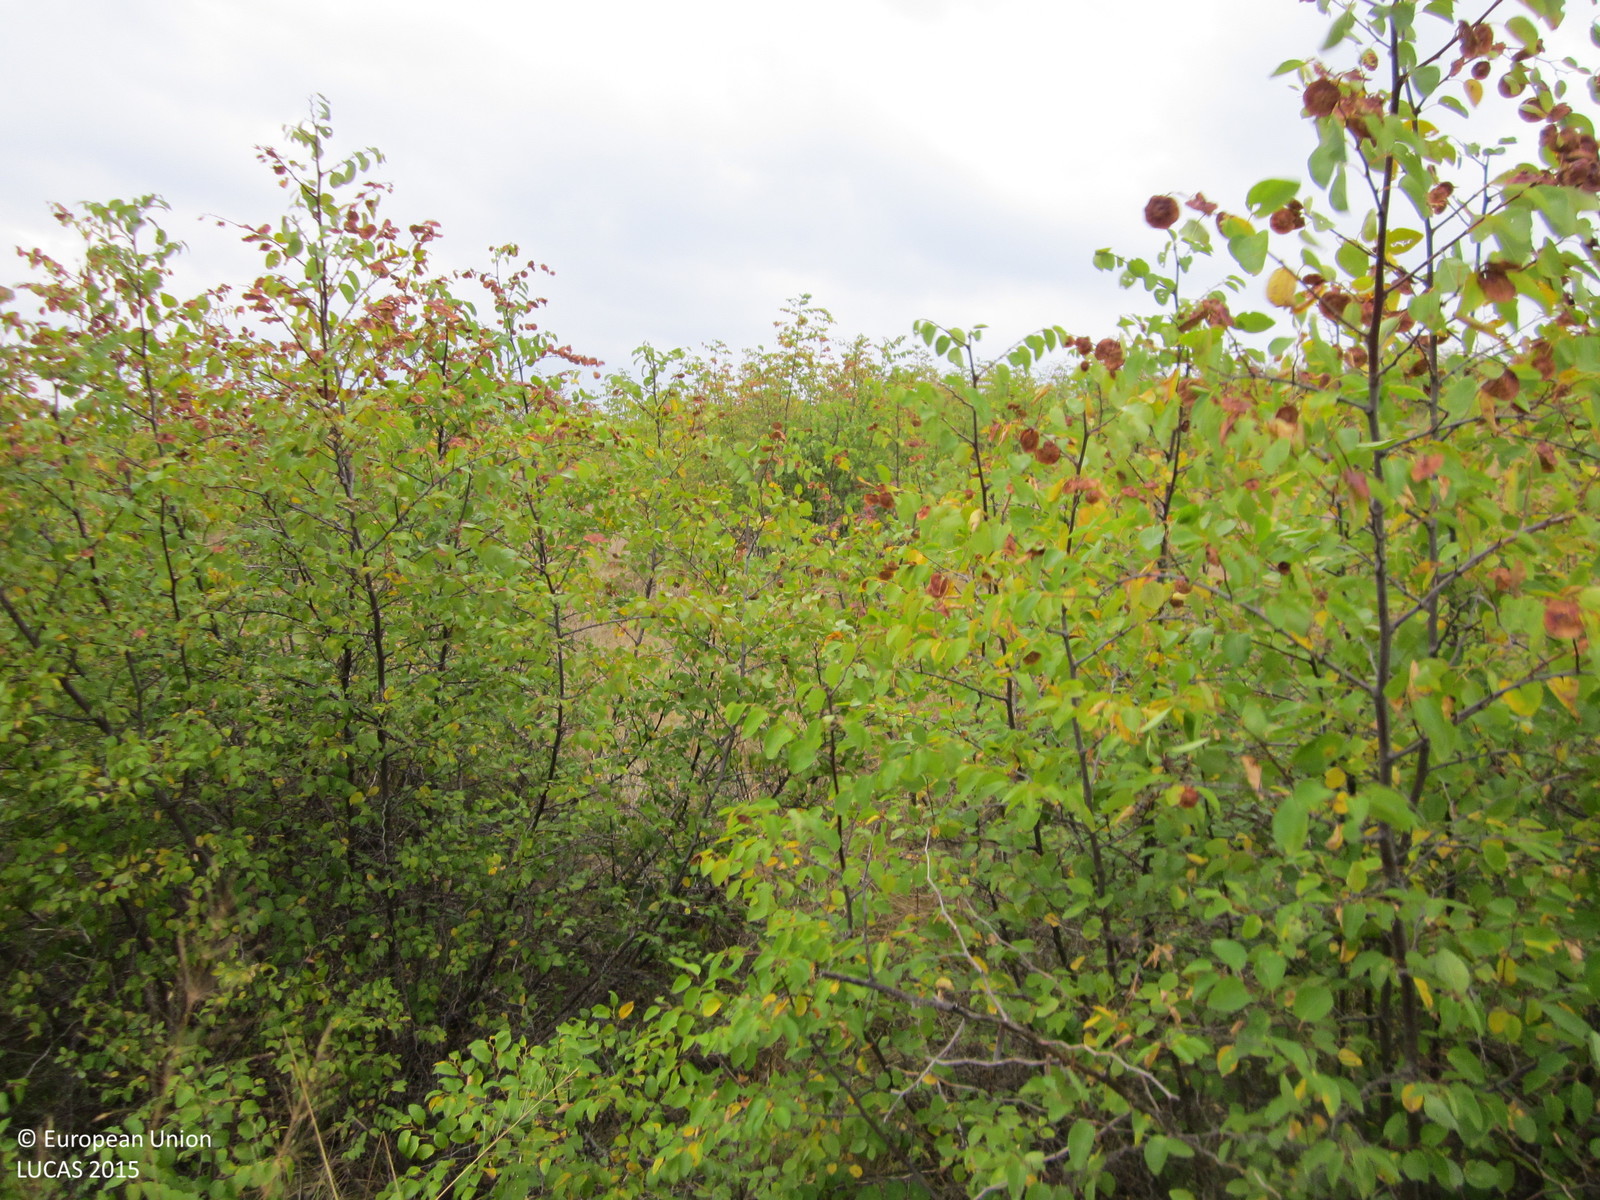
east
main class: Shrubland
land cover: Shrubland without tree cover
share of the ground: 50 - 75 %
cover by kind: shrubs 60 %, herbaceous plants 40 %
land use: Semi-natural and natural areas not in use
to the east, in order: Shrubland without tree cover; Grass margins; Tracks; Grass margins; Shrubland without tree cover
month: August
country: BG
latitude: 42.5237
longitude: 27.0388
